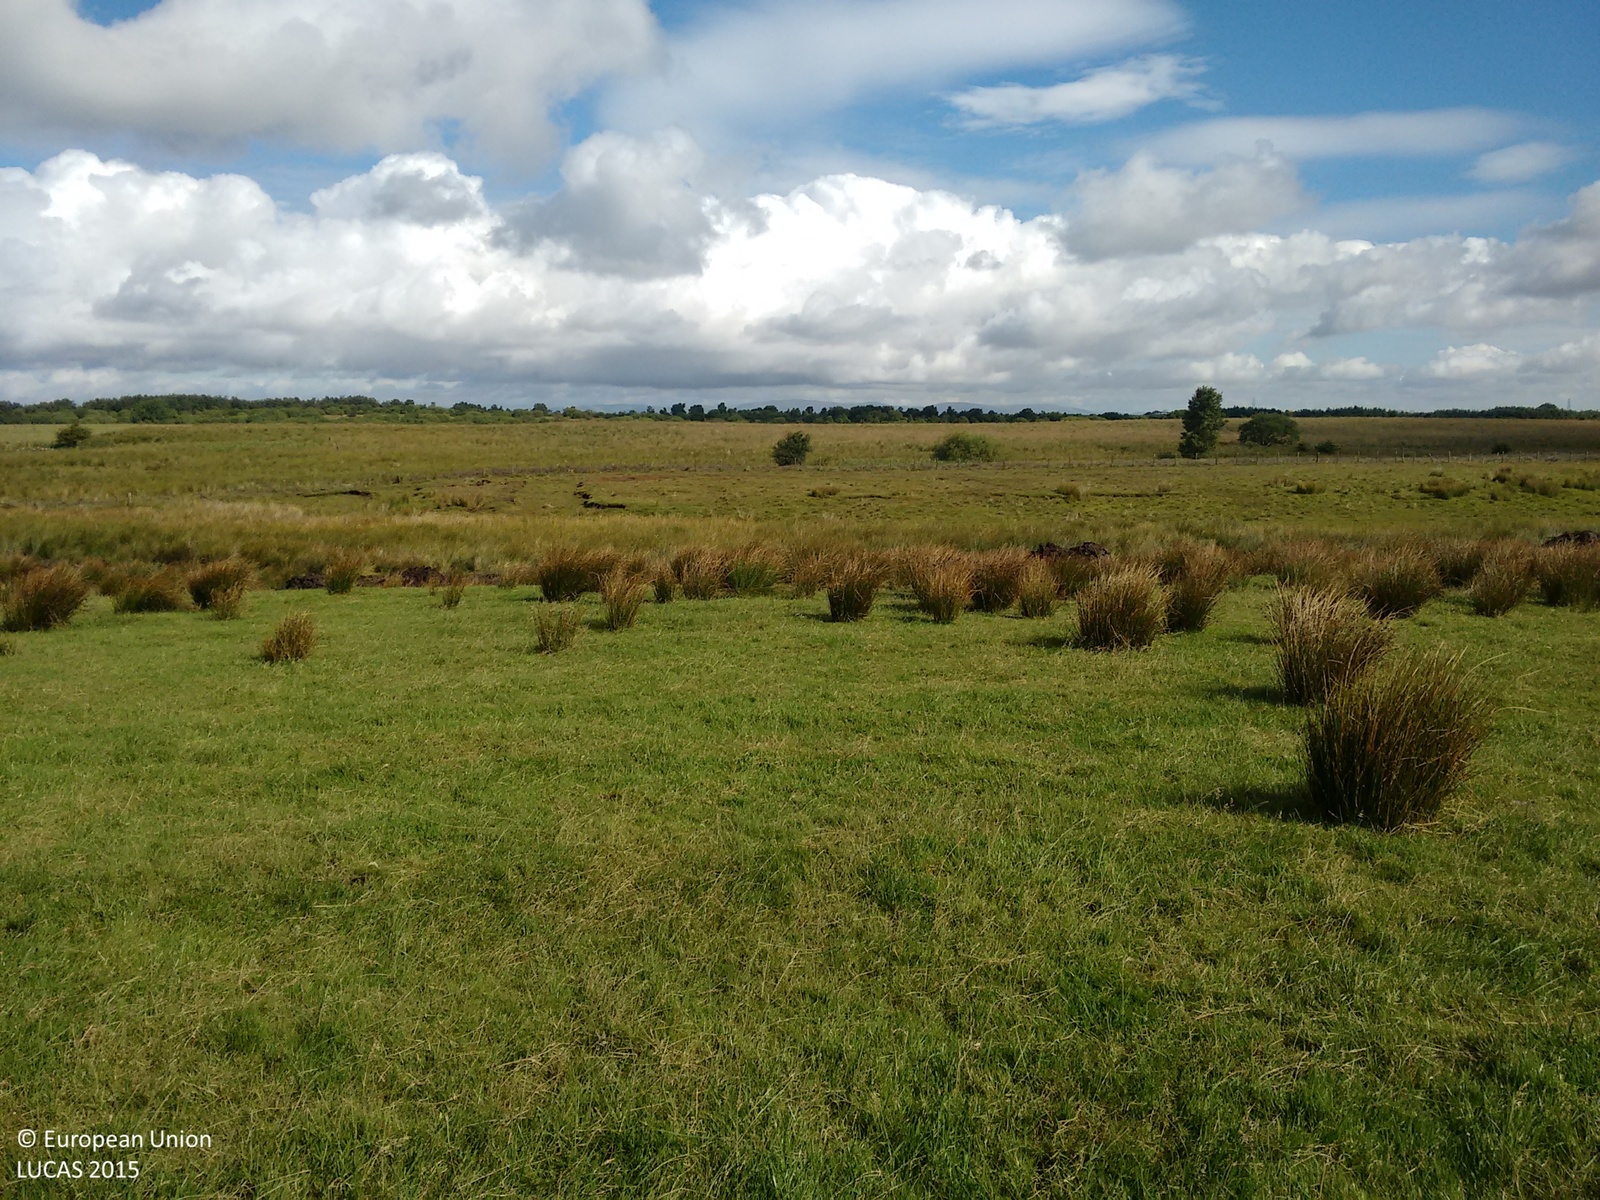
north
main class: Grassland
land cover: Grassland without tree/shrub cover
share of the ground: > 75 %
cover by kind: herbaceous plants 100 %
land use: Agriculture (excluding fallow land and kitchen gardens)
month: August
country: GB
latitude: 55.9515
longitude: -3.7754
